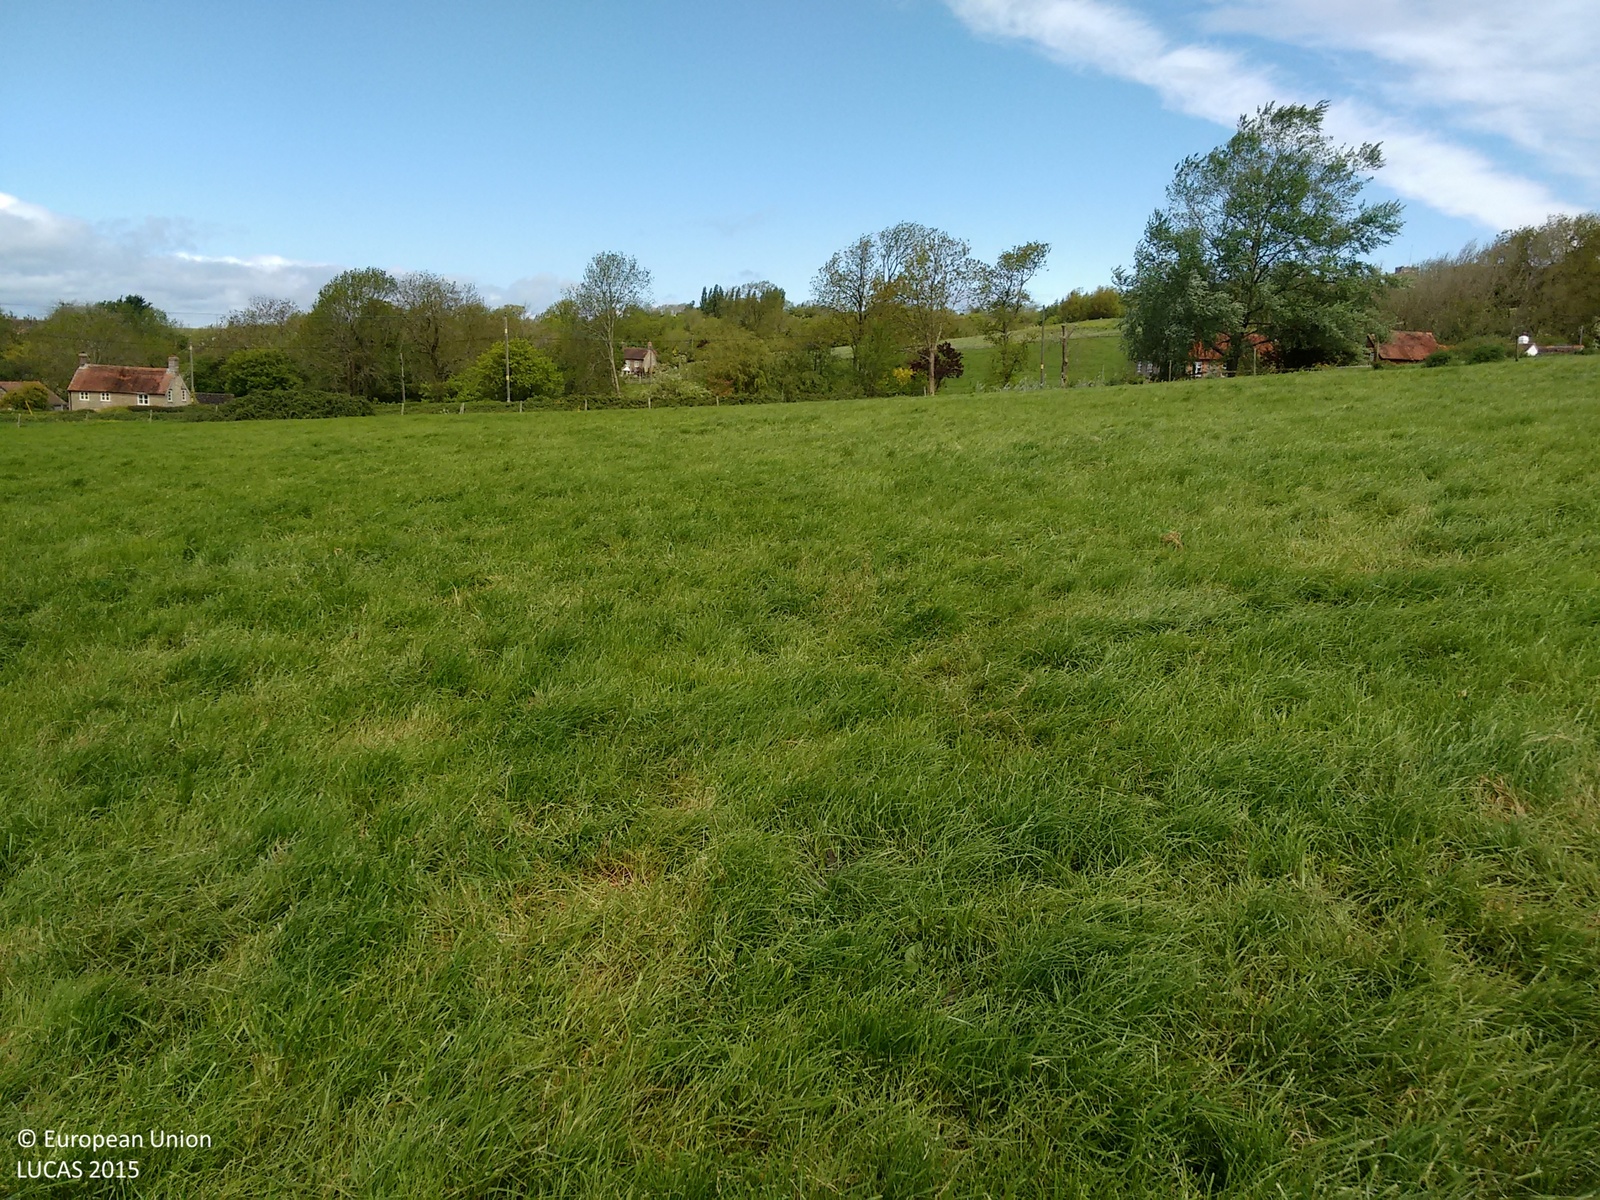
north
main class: Grassland
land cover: Grassland without tree/shrub cover
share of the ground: > 75 %
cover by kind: herbaceous plants 100 %
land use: Agriculture (excluding fallow land and kitchen gardens)
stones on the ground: < 10 %
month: May
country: GB
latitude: 51.0035
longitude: -2.3335
